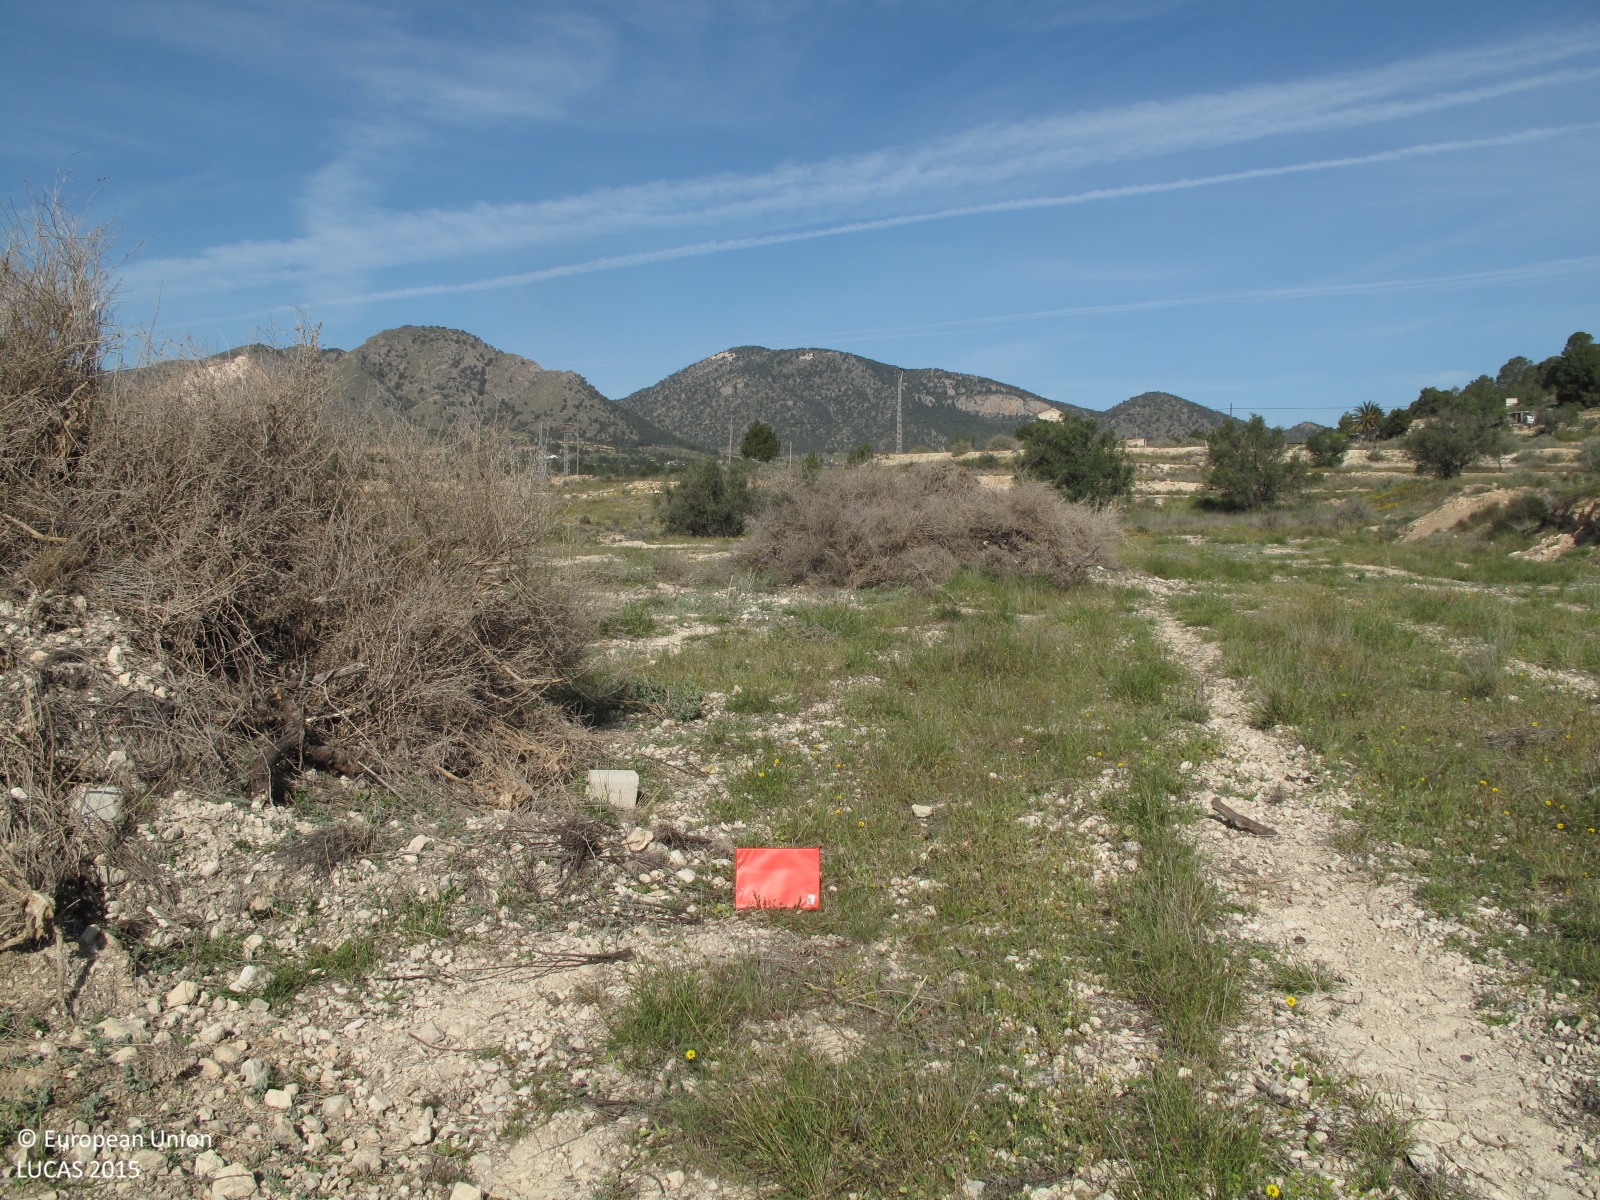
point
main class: Grassland
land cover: Spontaneously vegetated surfaces
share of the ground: 50 - 75 %
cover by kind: herbaceous plants 60 %, unconsolidated bare surface 40 %
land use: Abandoned areas
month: April
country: ES
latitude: 38.3806
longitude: -0.8969
